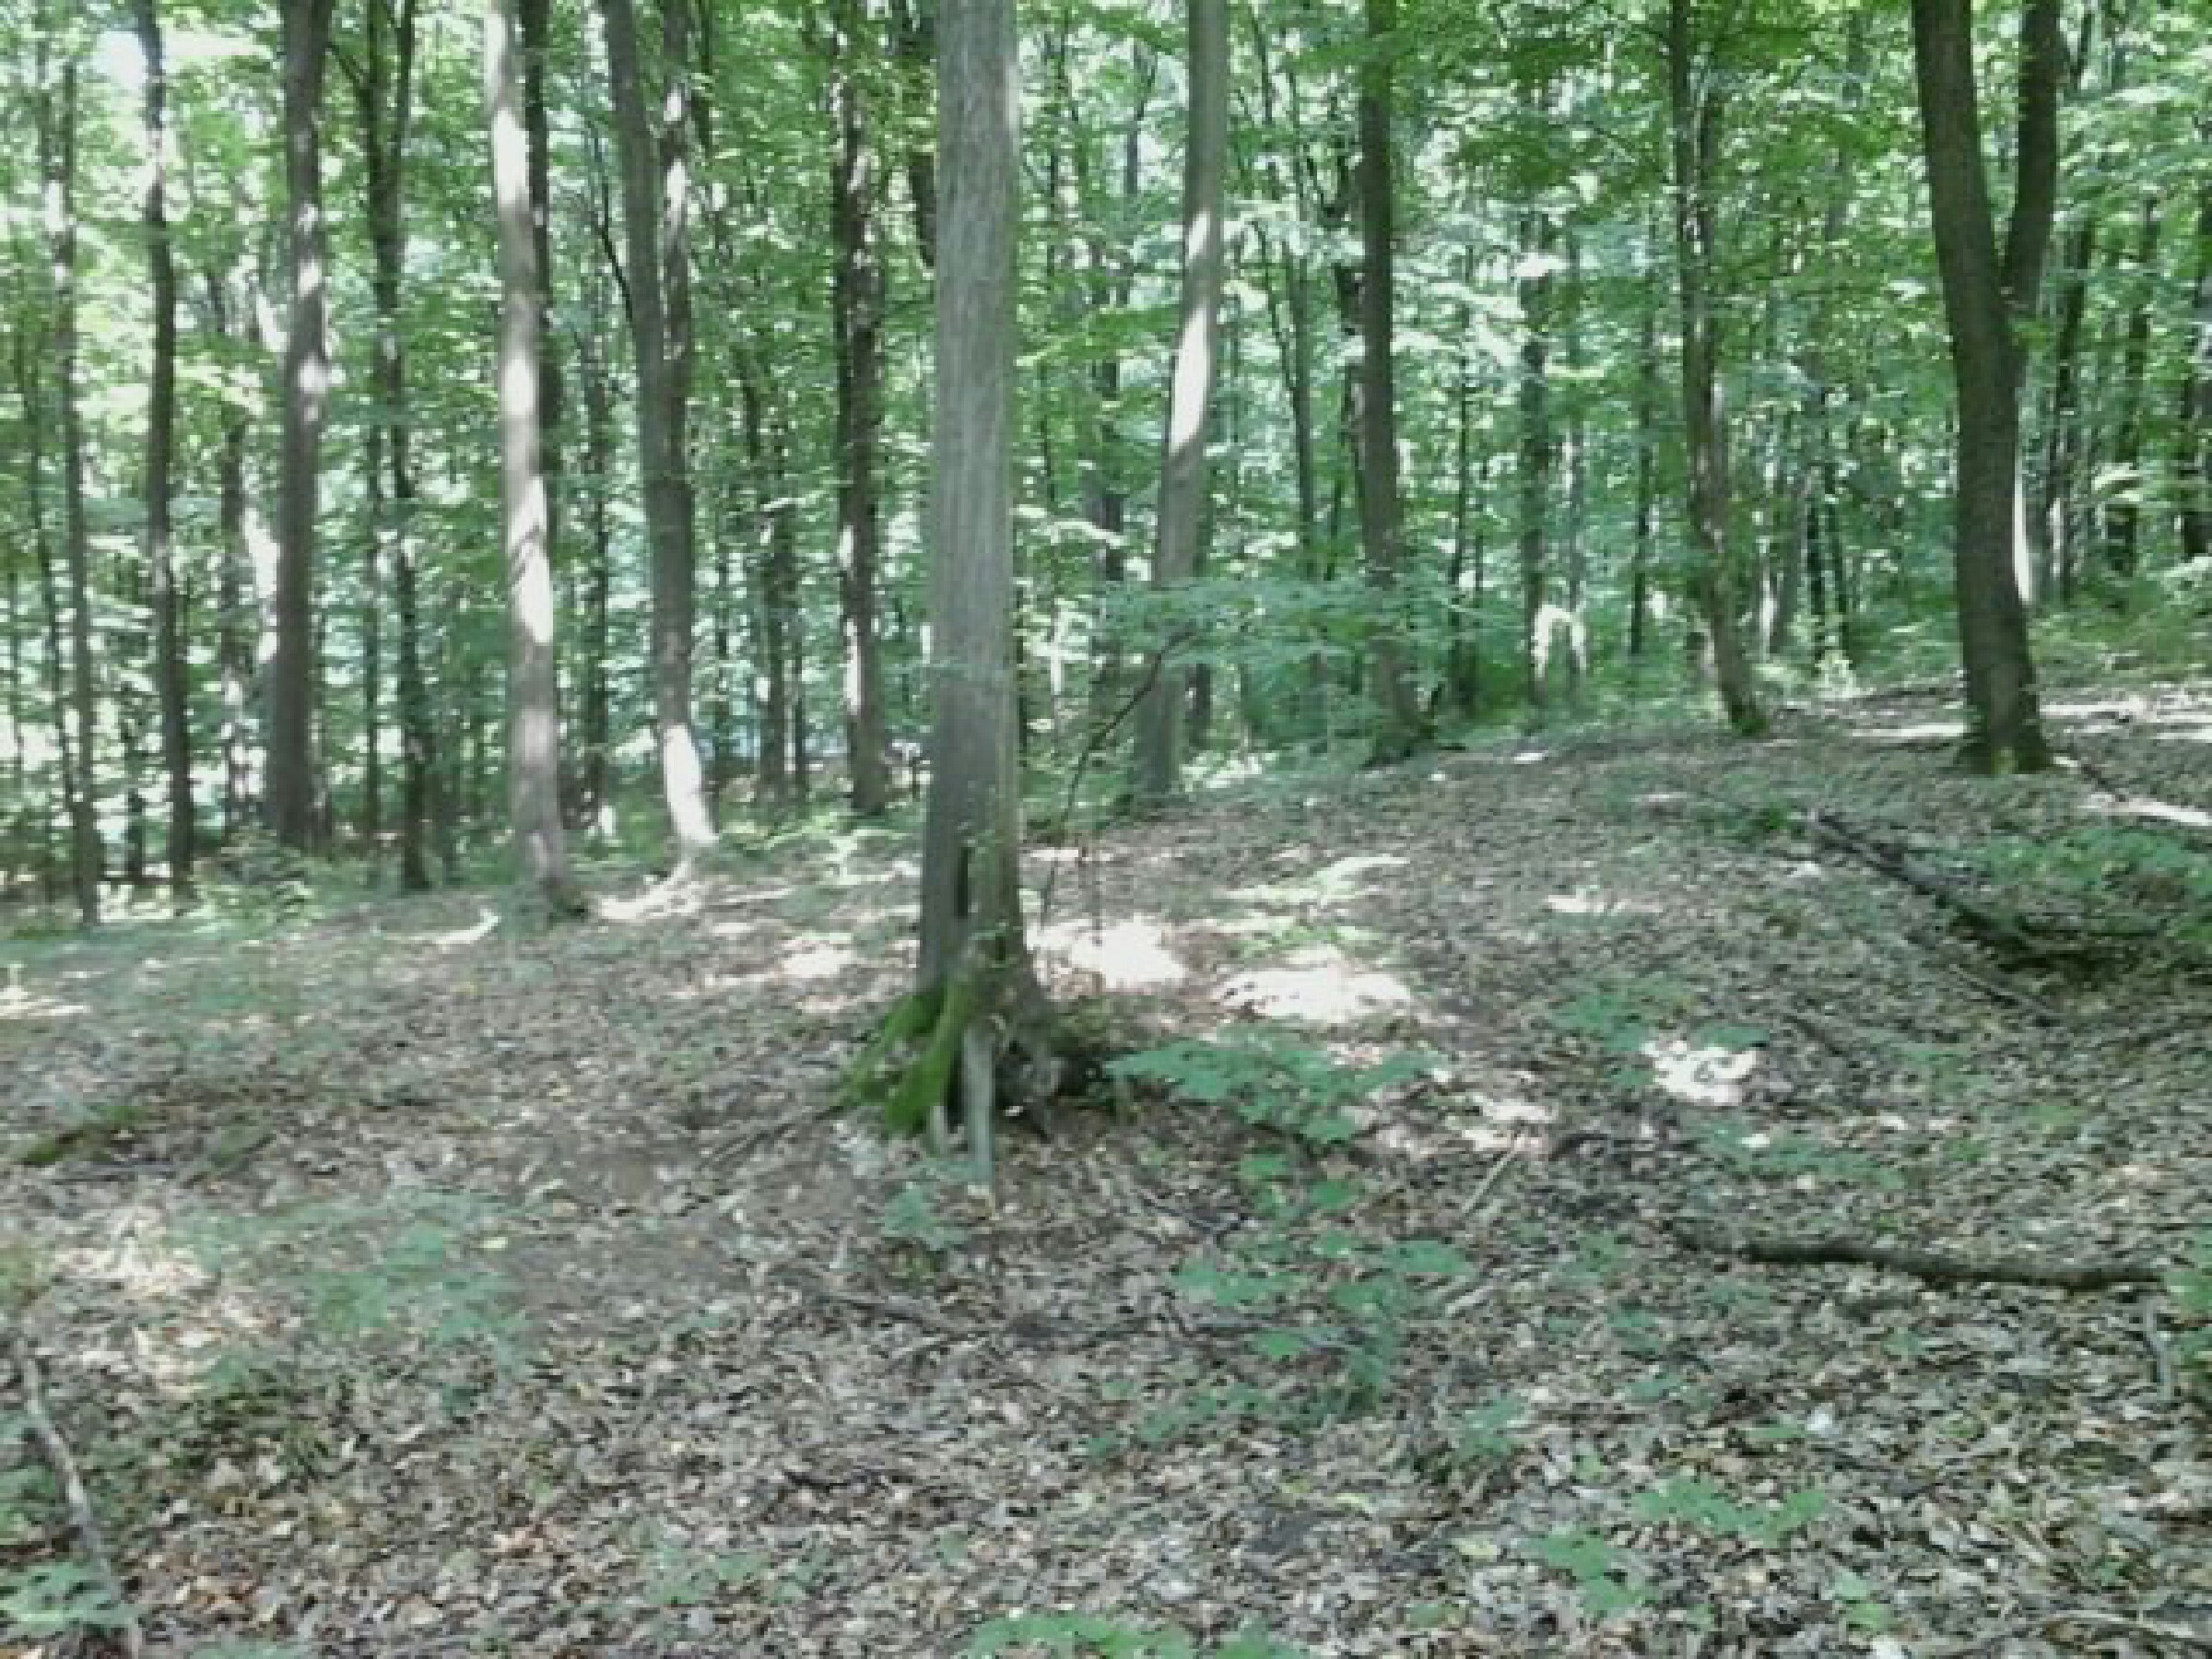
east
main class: Woodland
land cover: Broadleaved woodland
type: mesophytic deciduous forest
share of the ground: > 75 %
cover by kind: broadleaved forest trees 100 %
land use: Forestry
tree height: > 5 m
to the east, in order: Broadleaved woodland; Ditches and canals; Broadleaved woodland; Tracks; Broadleaved woodland; Tracks; Broadleaved woodland; Ditches and canals; Broadleaved woodland; Ditches and canals; Broadleaved woodland
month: July
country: HU
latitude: 47.8404
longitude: 19.1727
